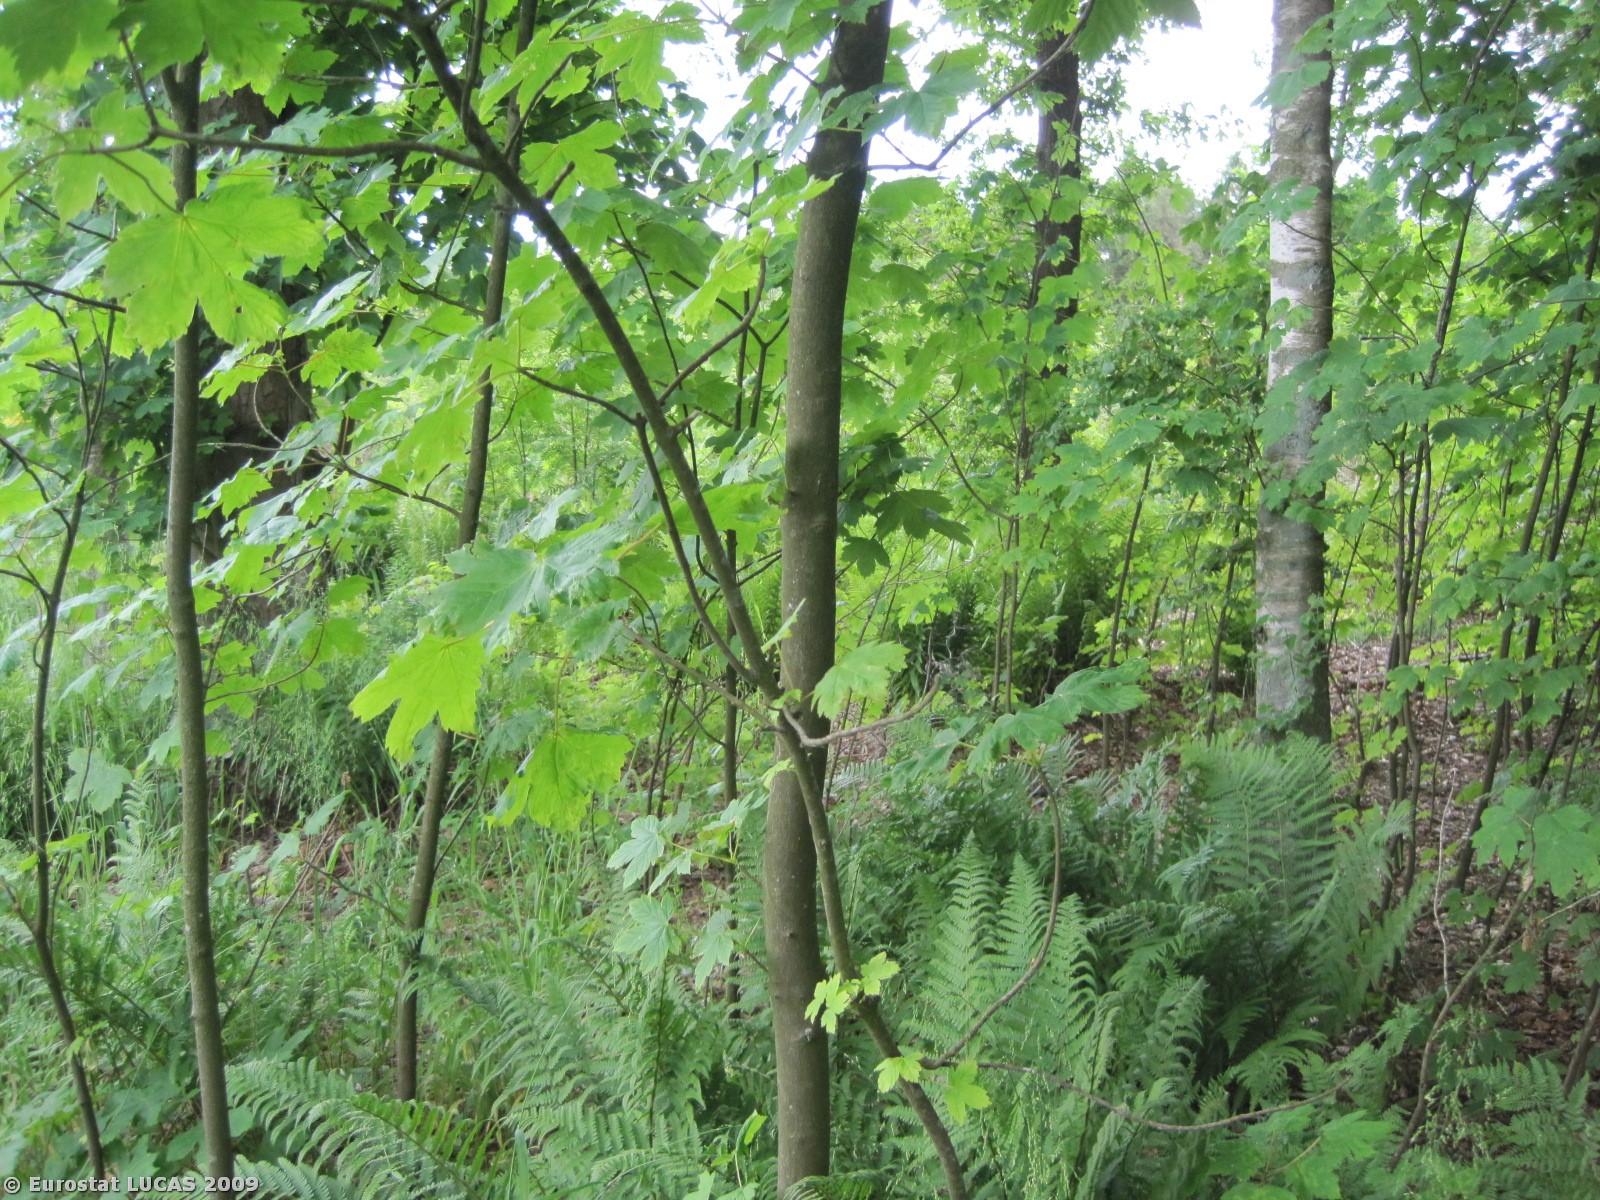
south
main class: Woodland
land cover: Mixed woodland
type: plantations and self-sown exotic forest
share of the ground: 50 - 75 %
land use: Agriculture (excluding fallow land and kitchen gardens)
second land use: Amenities, museums, leisure
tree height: > 5 m
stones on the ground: < 10 %
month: June
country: DK
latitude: 57.0865
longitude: 10.1483
